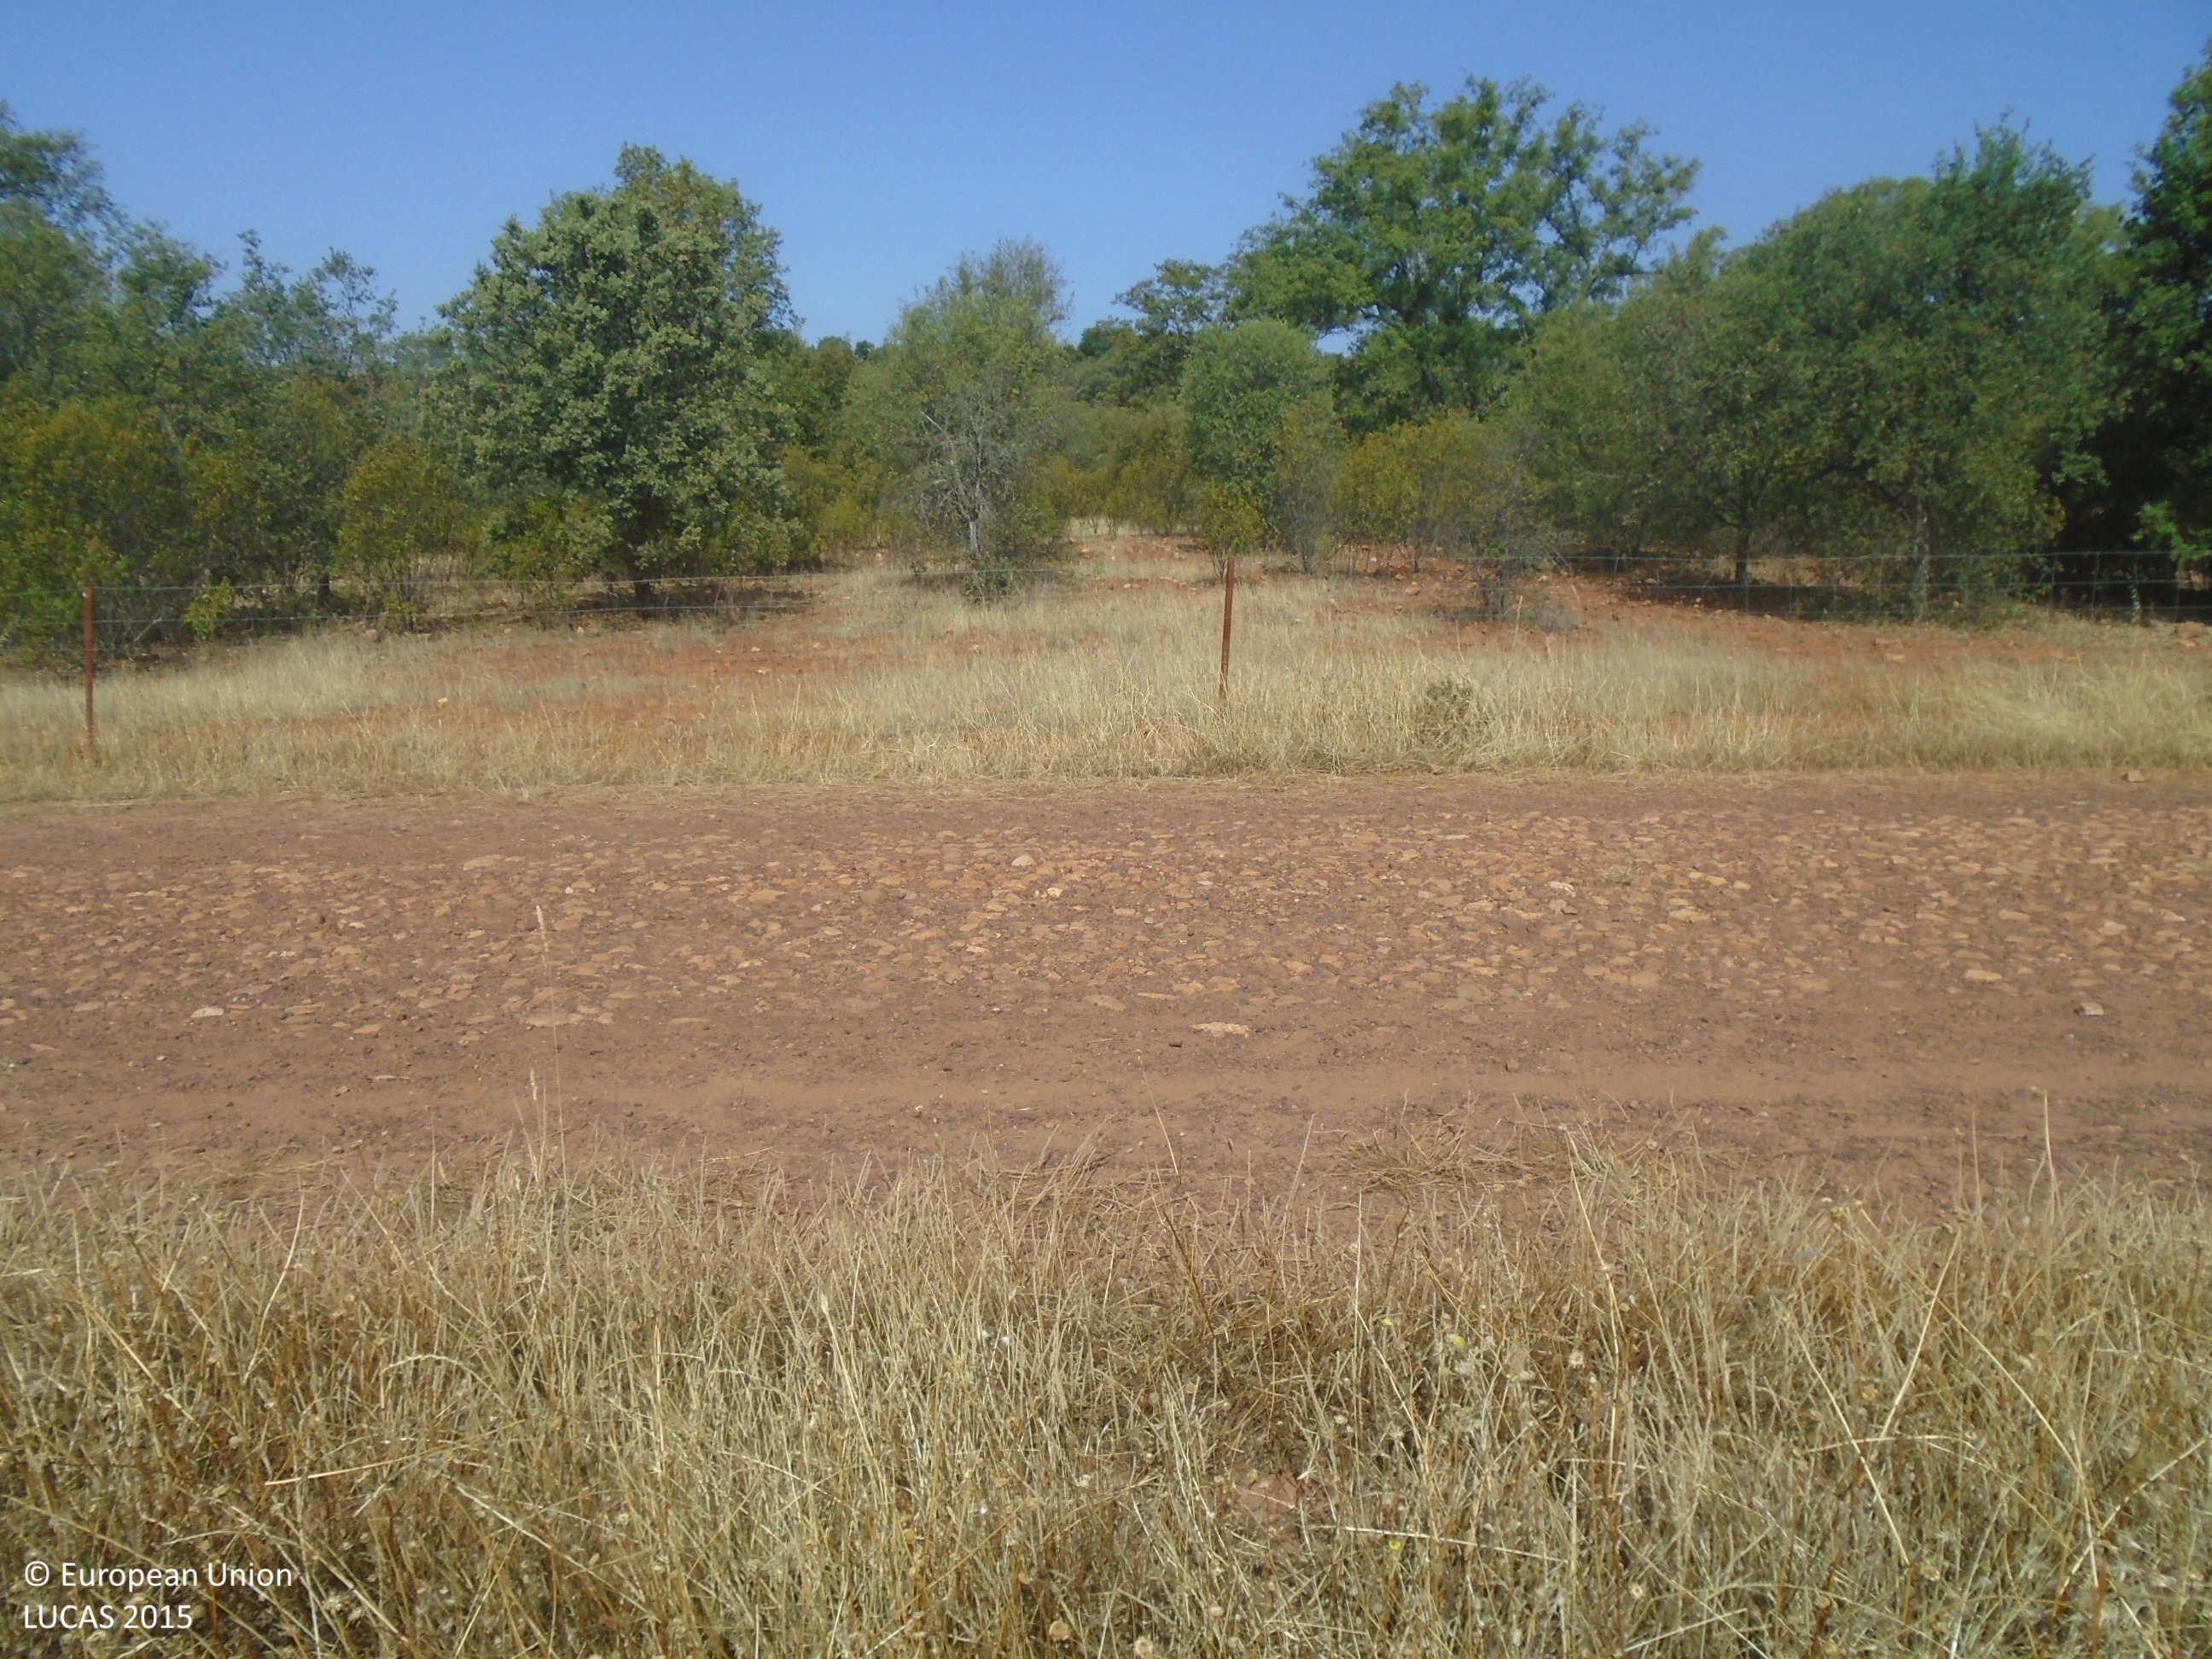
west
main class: Woodland
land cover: Broadleaved woodland
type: broadleaved evergreen forest
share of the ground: 10 - 25 %
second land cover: Oats
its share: > 75 %
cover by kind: broadleaved forest trees 15 %
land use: Forestry
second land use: Agriculture (excluding fallow land and kitchen gardens)
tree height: > 5 m
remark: Harvested field
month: July
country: ES
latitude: 39.3095
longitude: -4.5184
